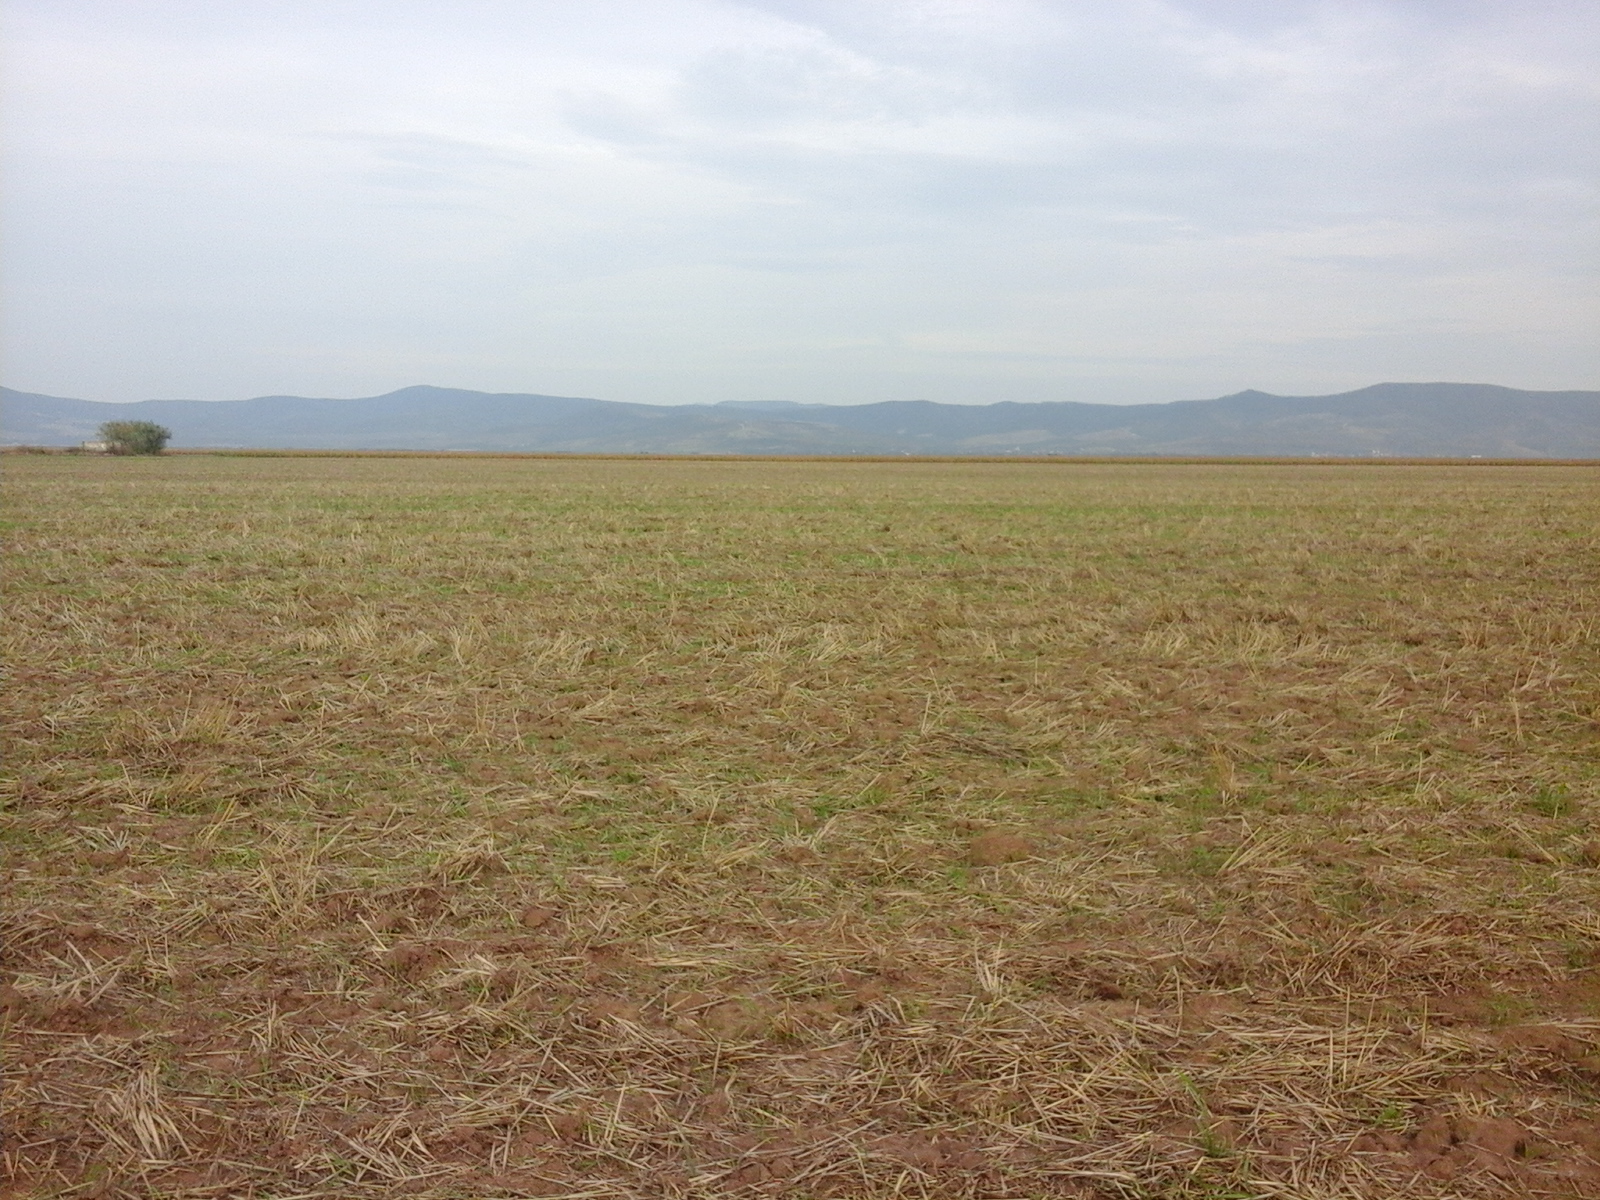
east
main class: Cropland
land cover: Common wheat
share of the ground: < 10 %
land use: Agriculture (excluding fallow land and kitchen gardens)
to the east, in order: Common wheat
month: August
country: RO
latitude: 46.2159
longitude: 21.5348
